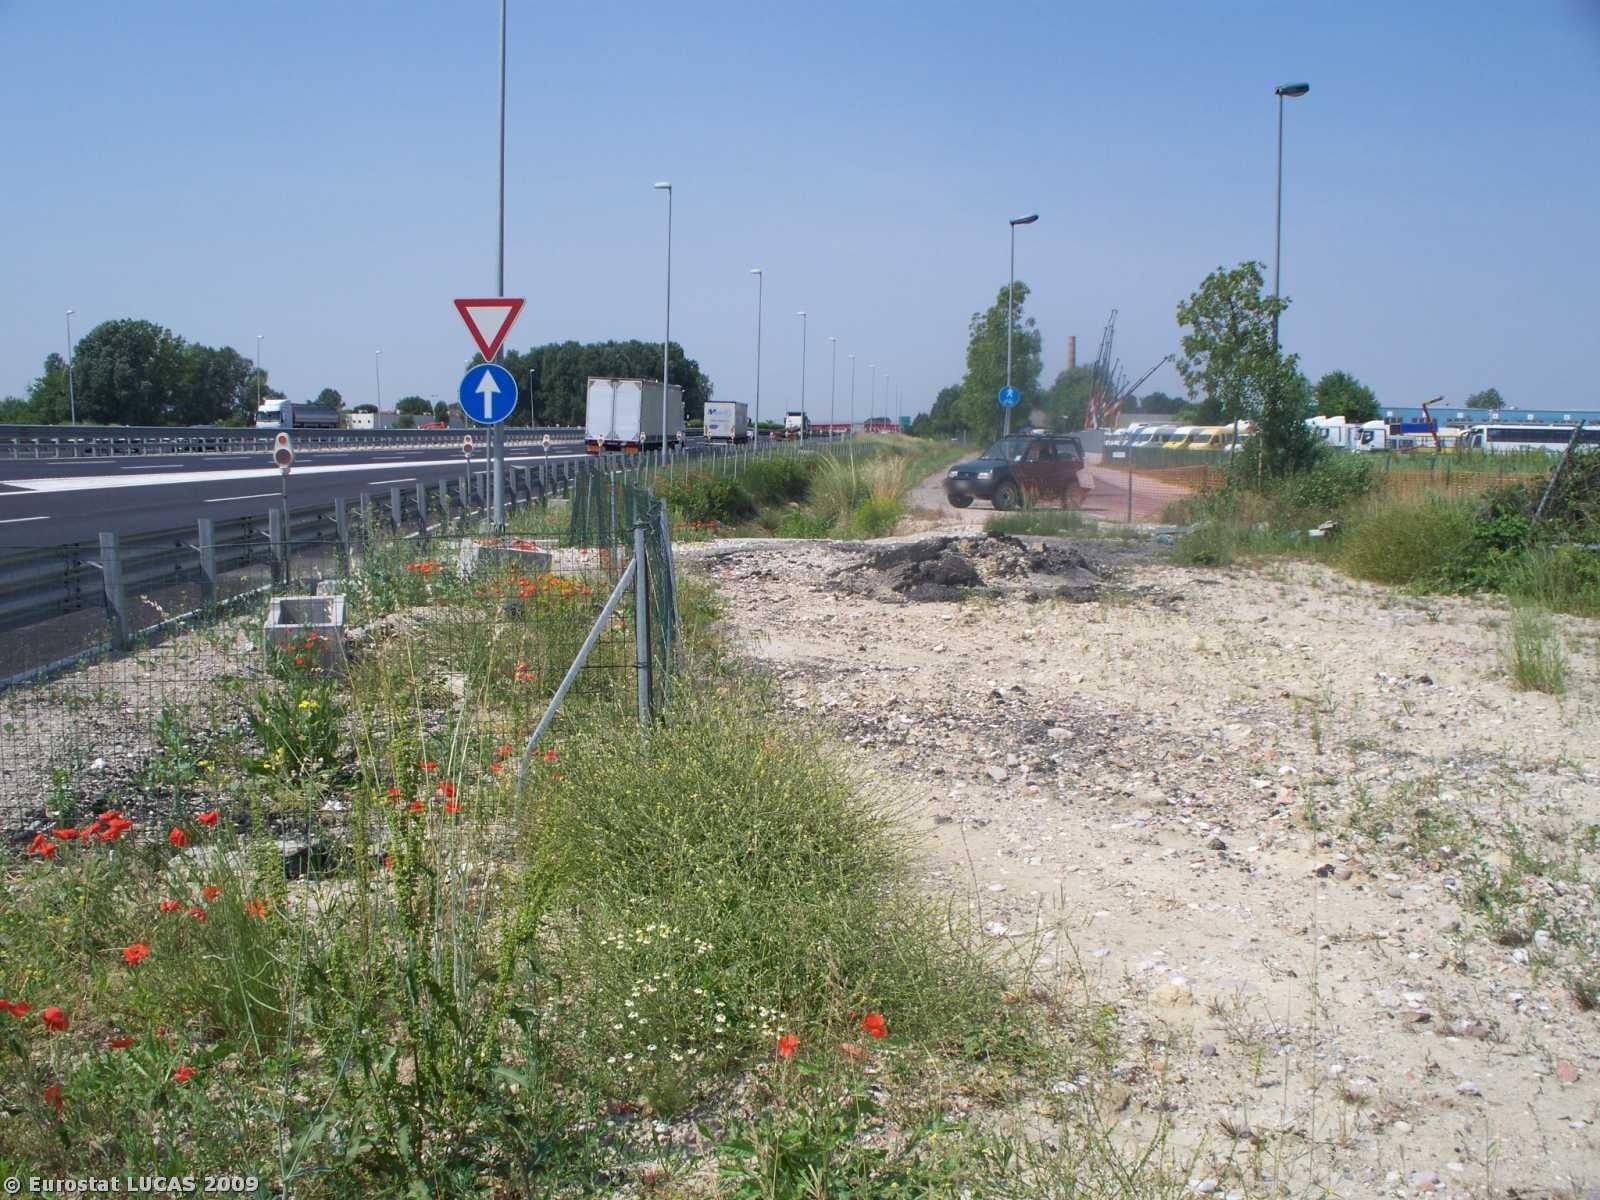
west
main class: Grassland
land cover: Spontaneously vegetated surfaces
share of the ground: 50 - 75 %
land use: Construction
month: May
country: IT
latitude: 45.4479
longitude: 12.0808
